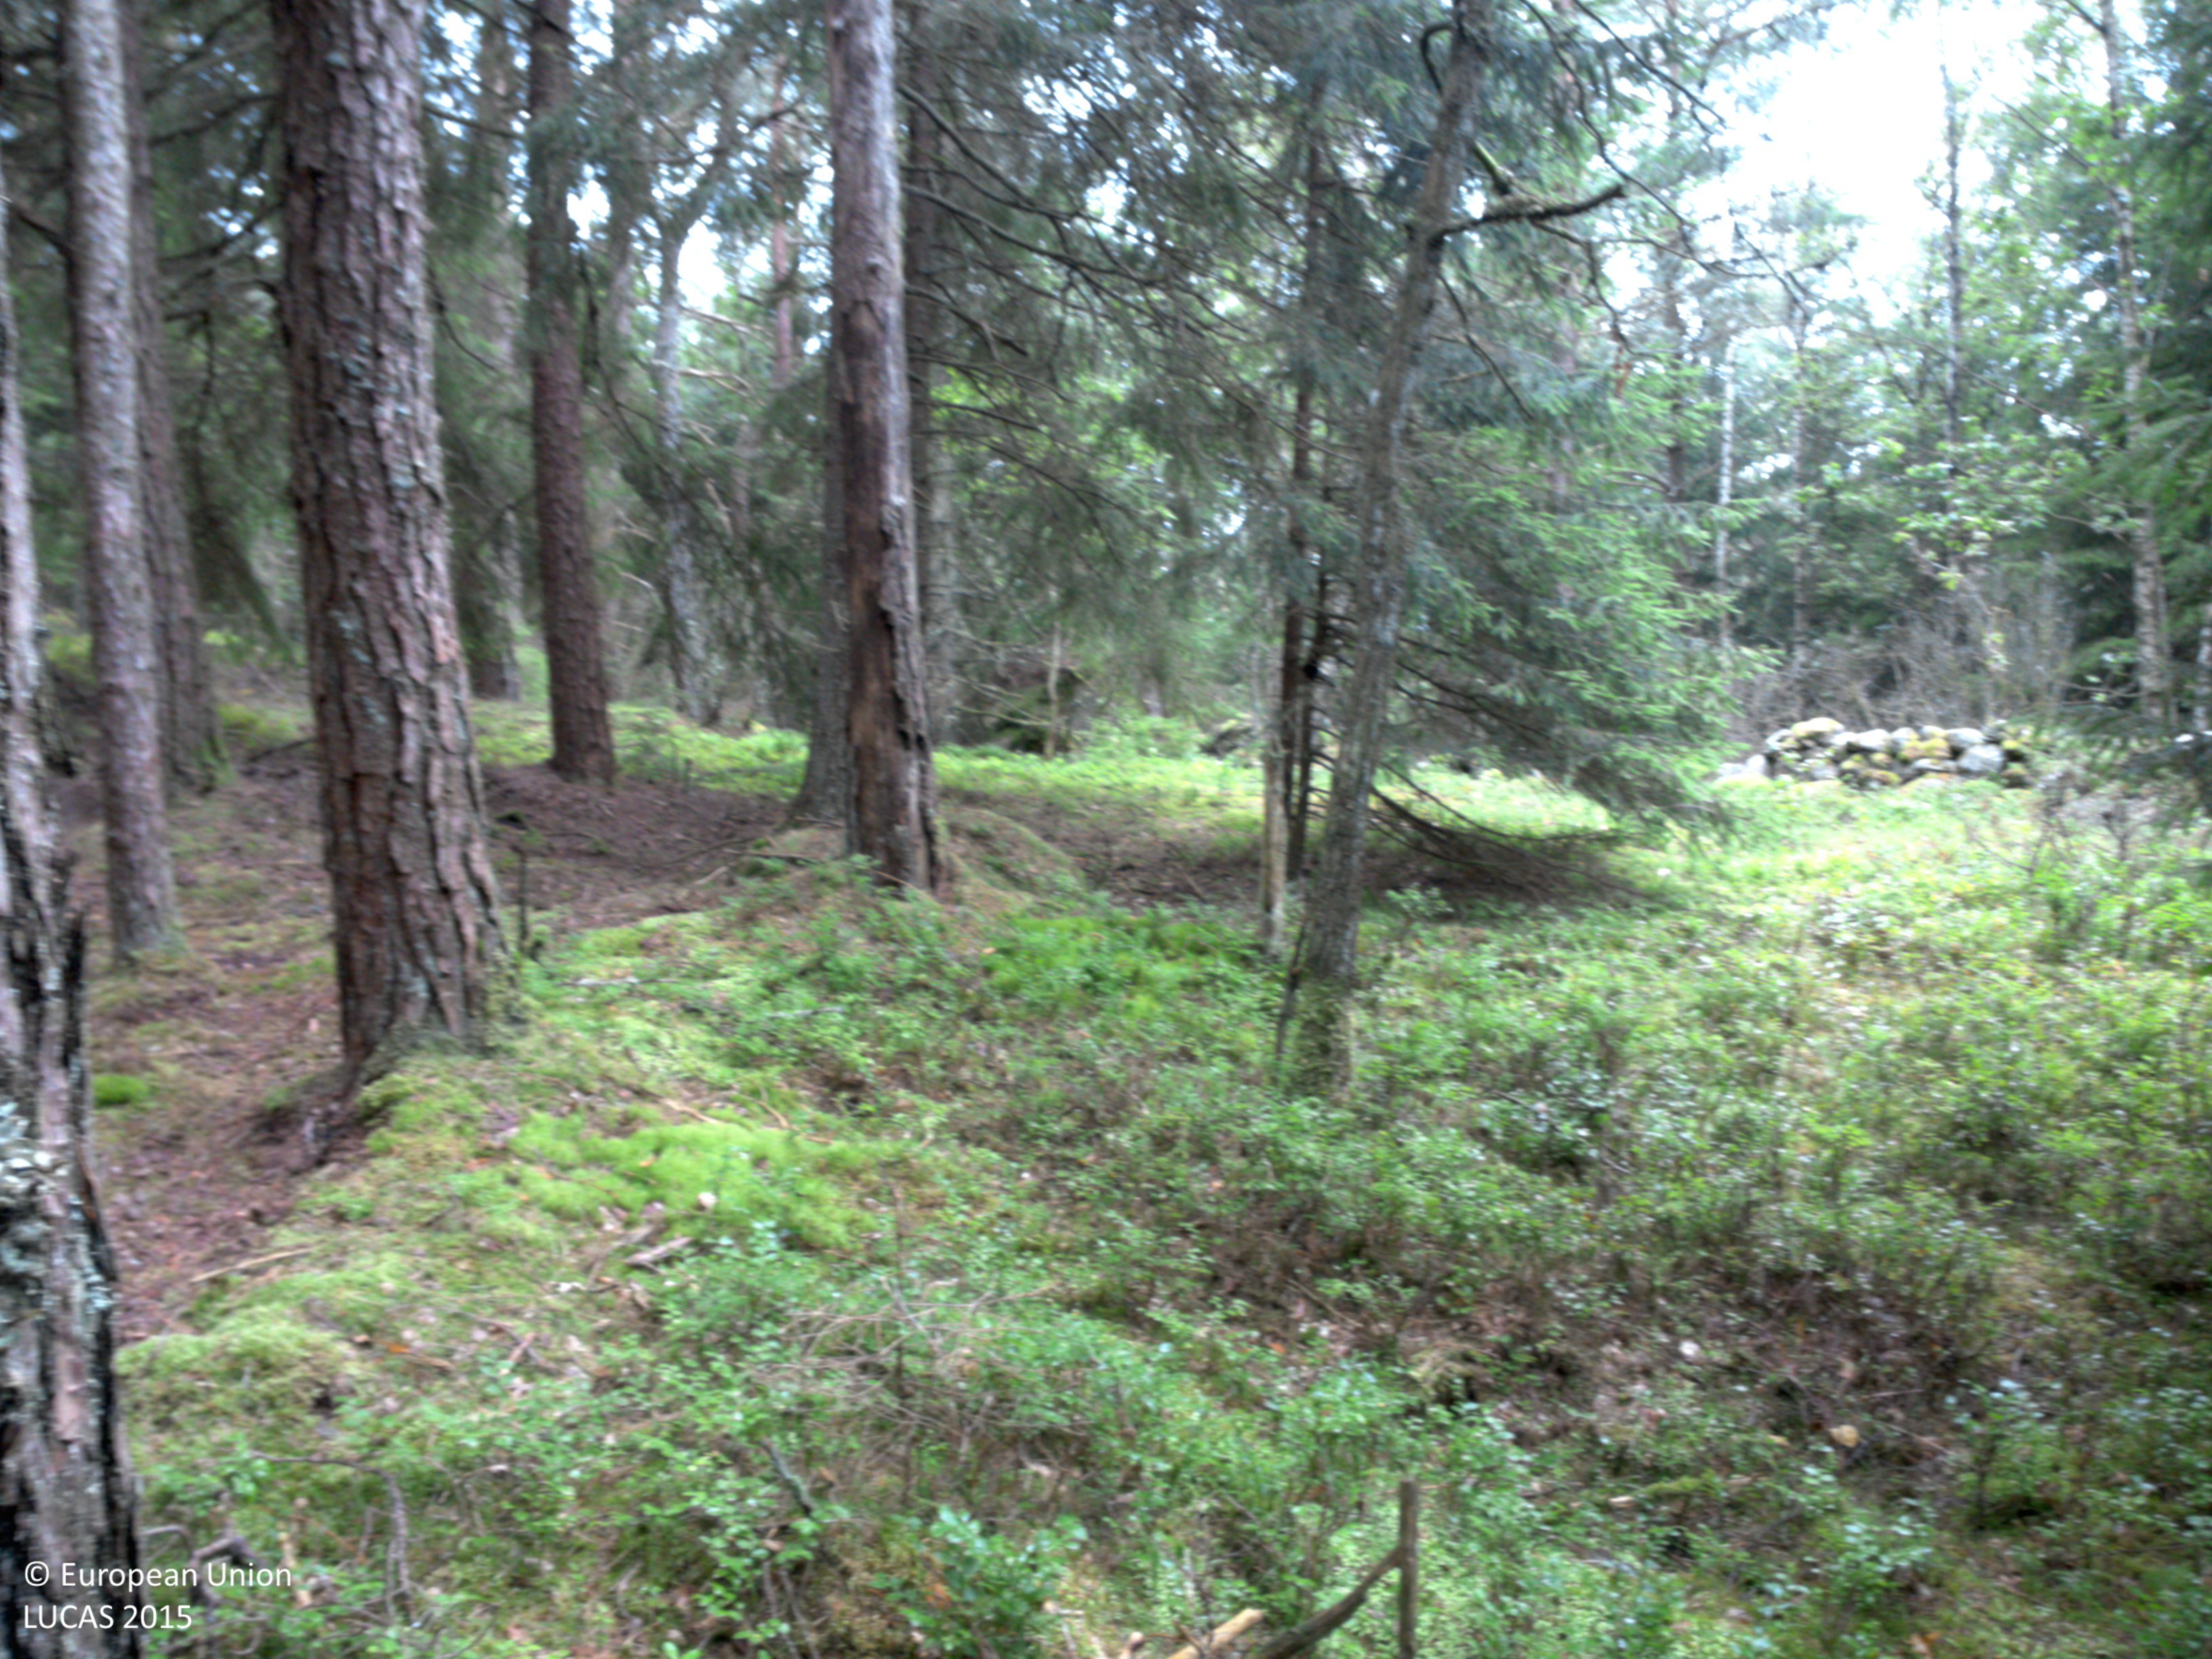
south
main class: Woodland
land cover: Other coniferous woodland
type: boreal forest
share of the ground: 50 - 75 %
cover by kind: coniferous forest trees 70 %, herbaceous plants 15 %, lichens and mosses 10 %, shrubs 5 %
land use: Forestry
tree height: > 5 m
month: August
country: SE
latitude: 57.9191
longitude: 11.8367
